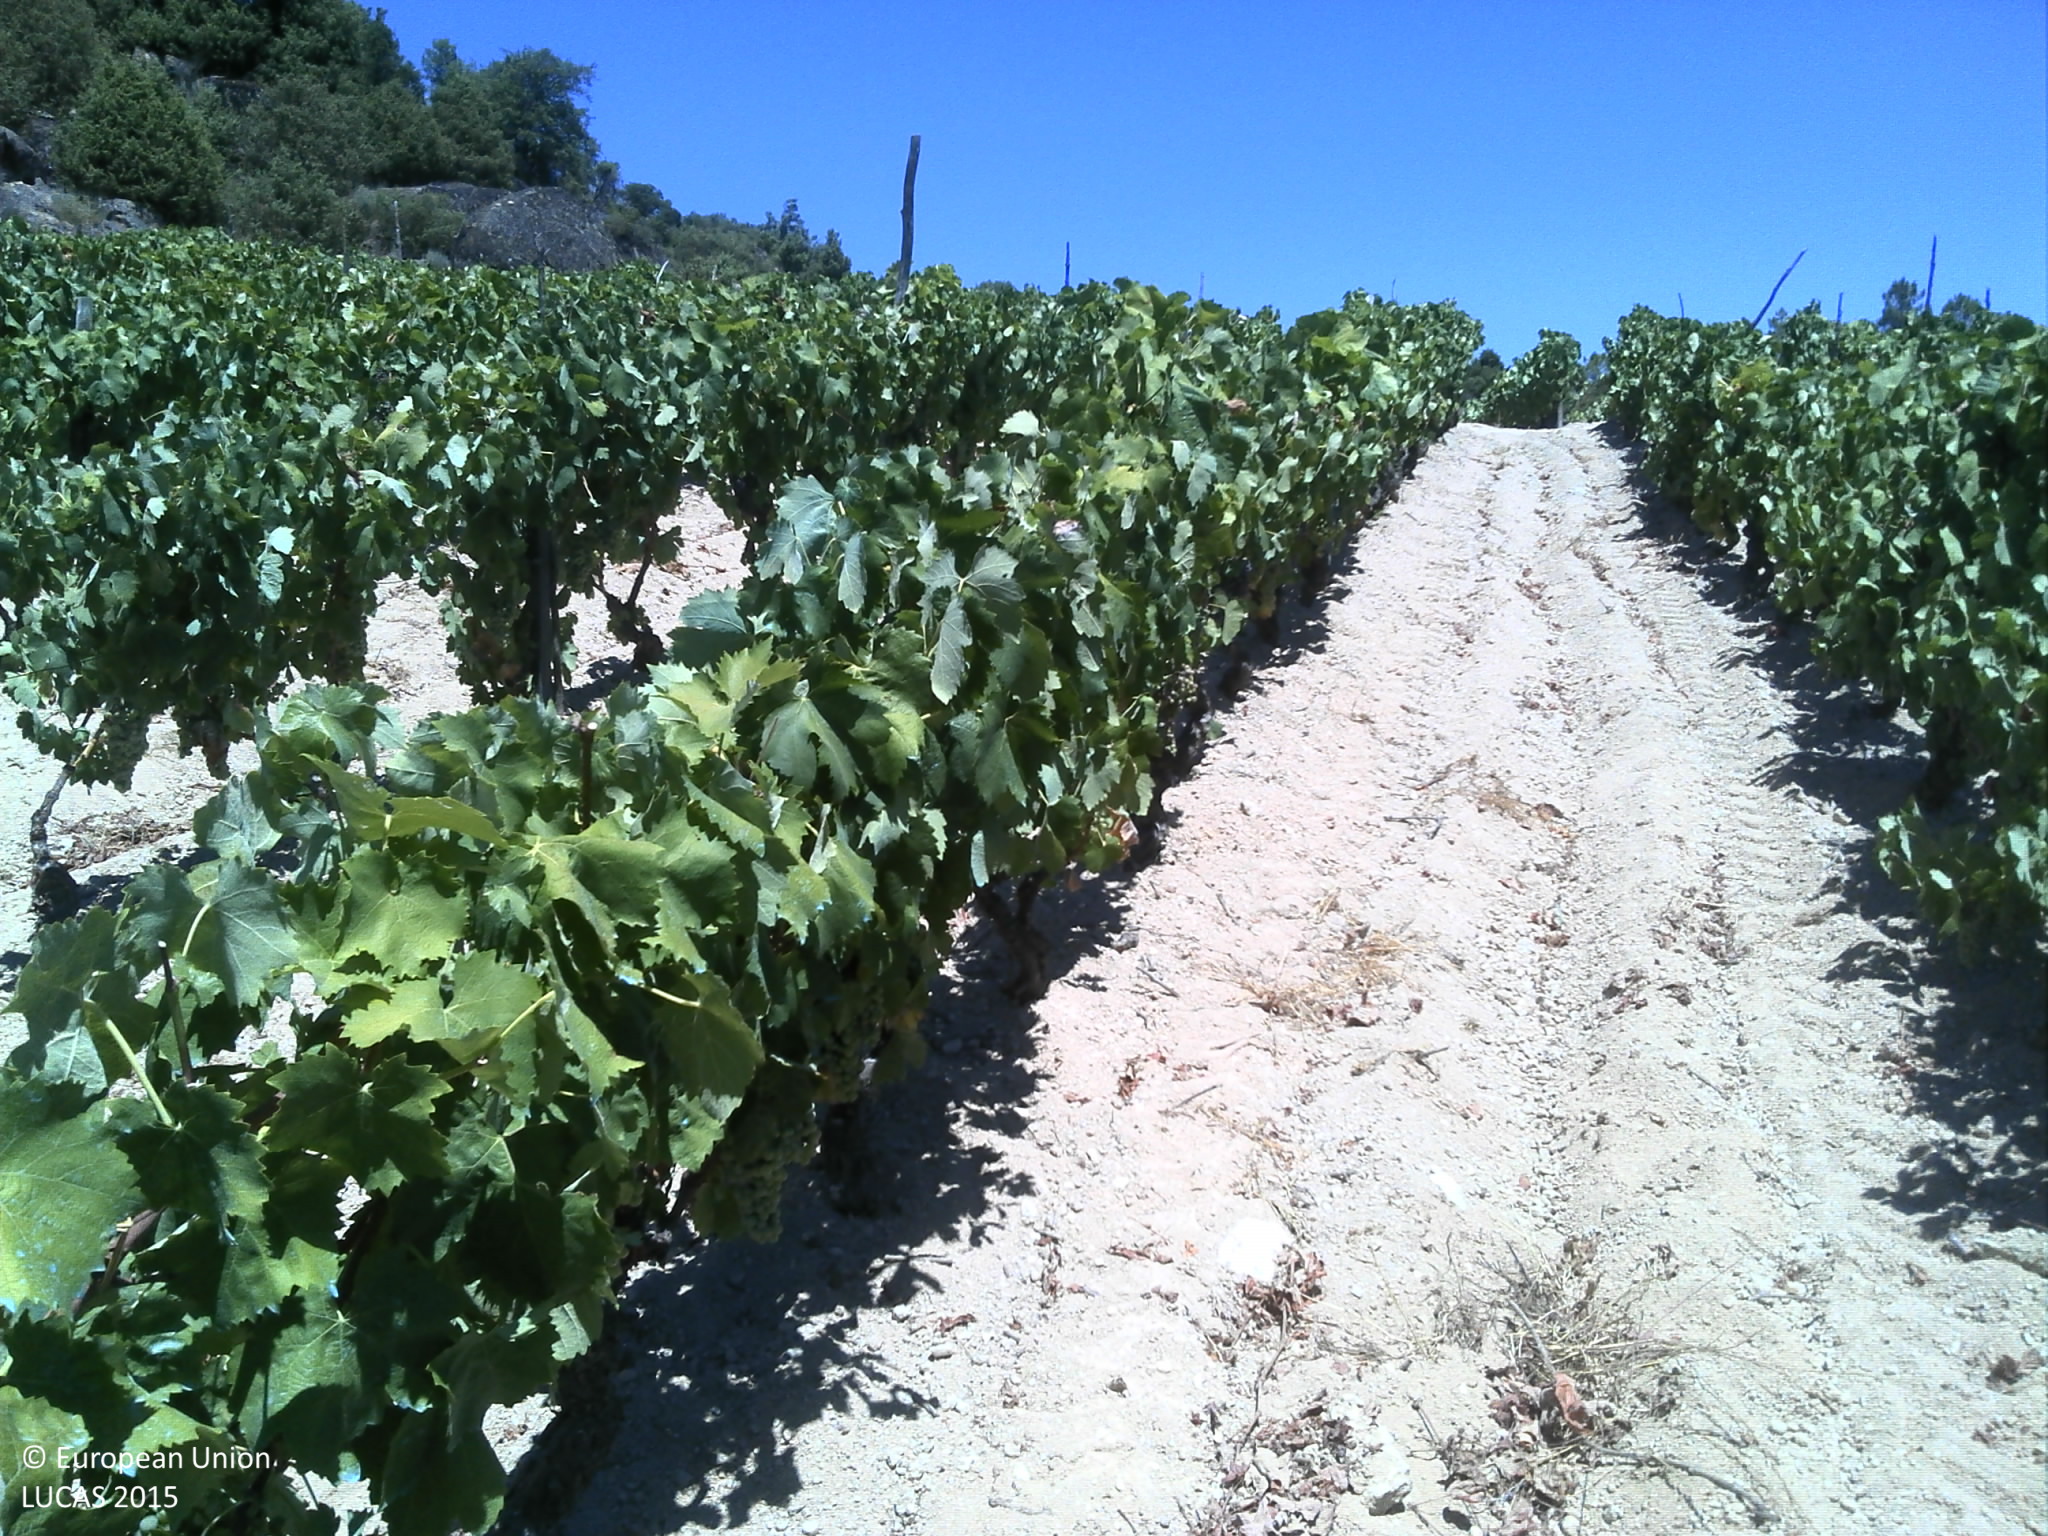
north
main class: Cropland
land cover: Vineyards
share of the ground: 10 - 25 %
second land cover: Other bare soil
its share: > 75 %
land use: Agriculture (excluding fallow land and kitchen gardens)
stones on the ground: 25 - 50 %
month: July
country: PT
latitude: 41.1963
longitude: -7.1529
